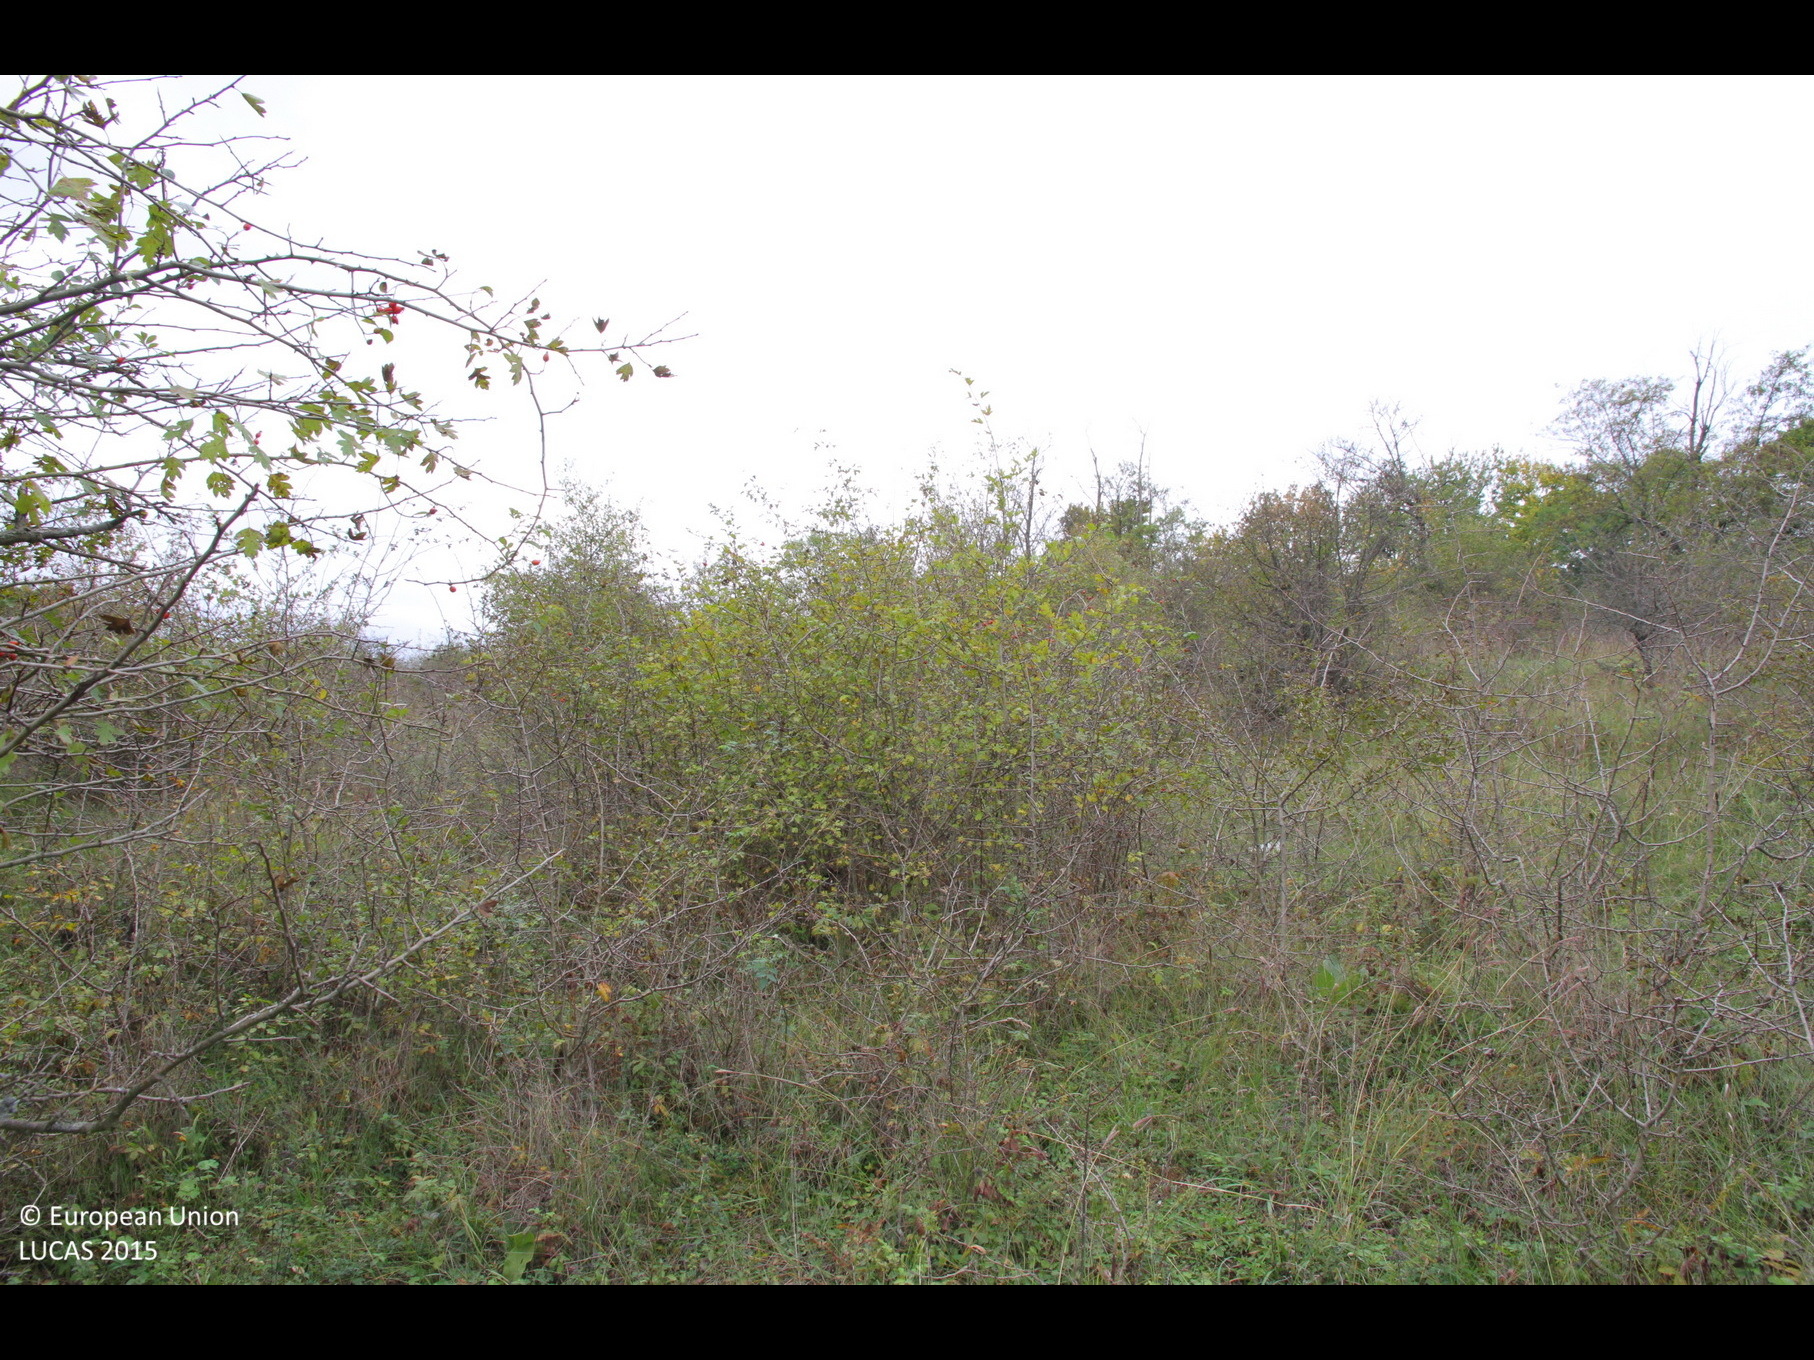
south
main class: Grassland
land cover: Grassland with sparse tree/shrub cover
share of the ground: > 75 %
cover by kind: herbaceous plants 85 %, shrubs 10 %, broadleaved forest trees 5 %
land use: Agriculture (excluding fallow land and kitchen gardens)
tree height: < 5 m
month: October
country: BG
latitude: 43.5068
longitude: 27.1027
